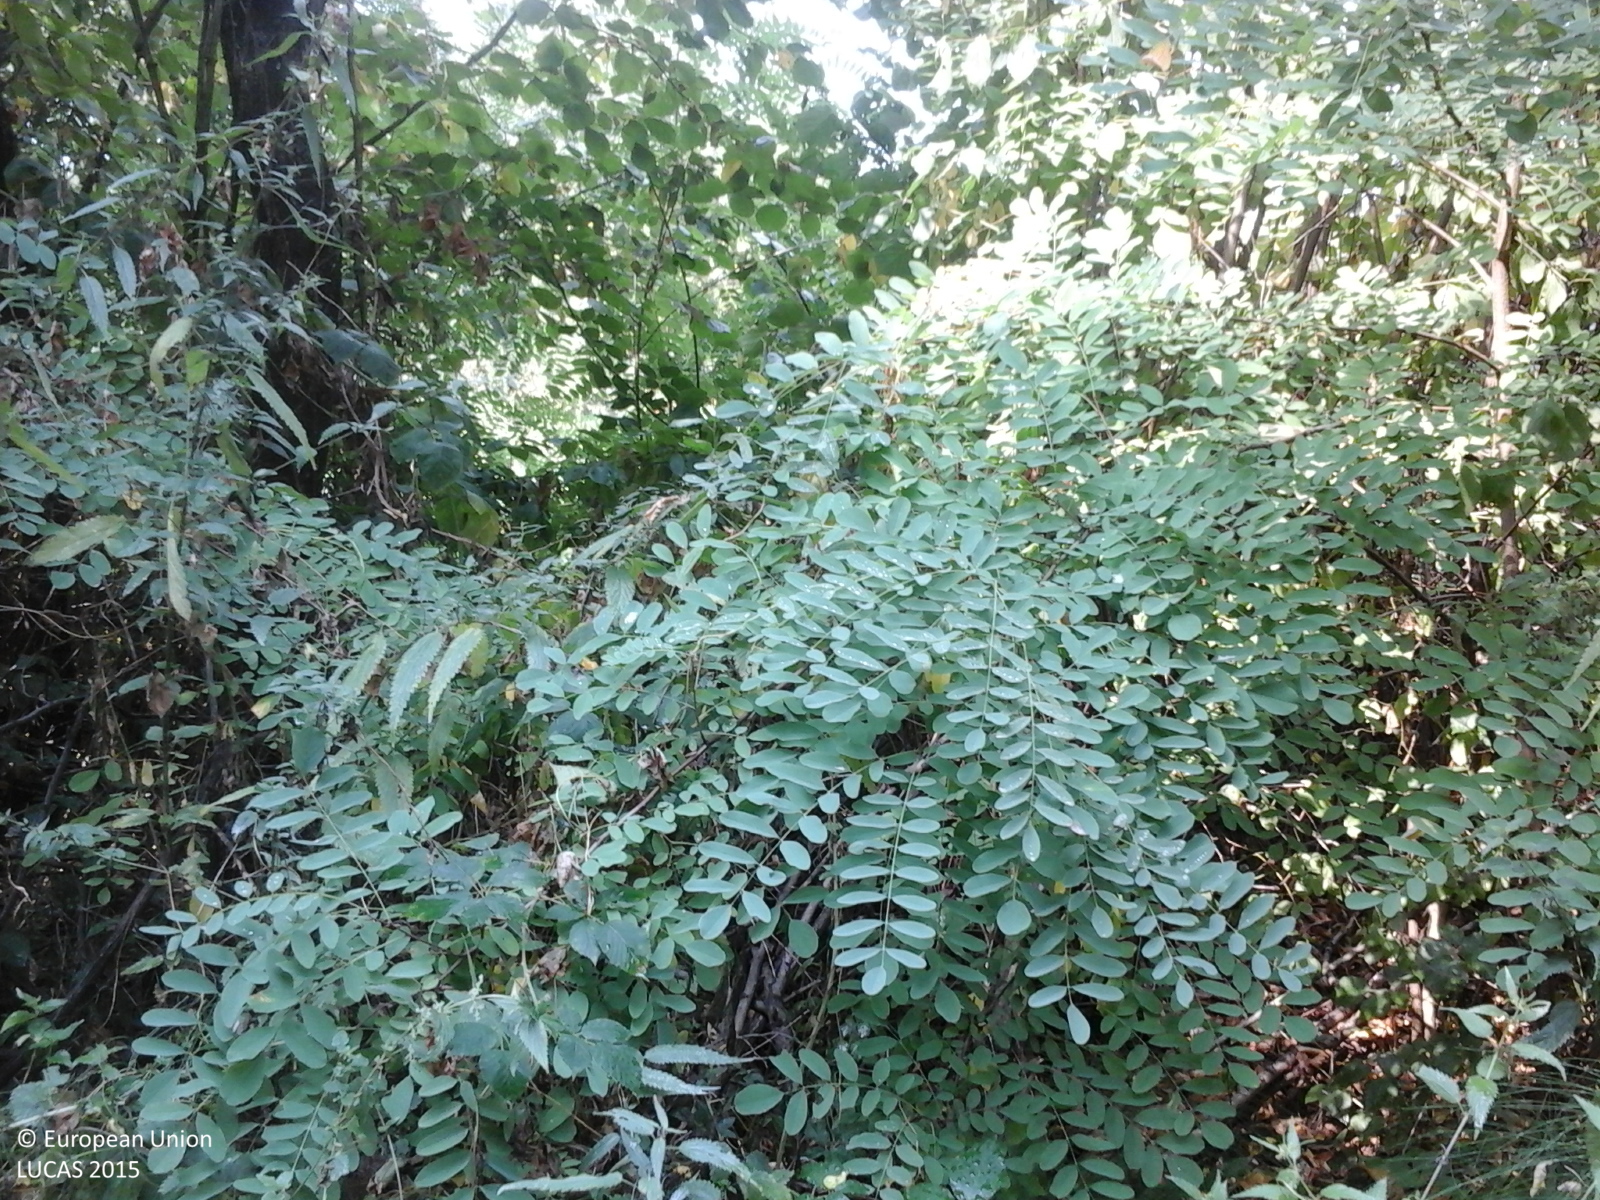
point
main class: Woodland
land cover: Broadleaved woodland
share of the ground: > 75 %
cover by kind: broadleaved forest trees 60 %, shrubs 40 %
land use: Abandoned areas
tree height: > 5 m
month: September
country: RO
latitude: 47.5384
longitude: 23.6134
